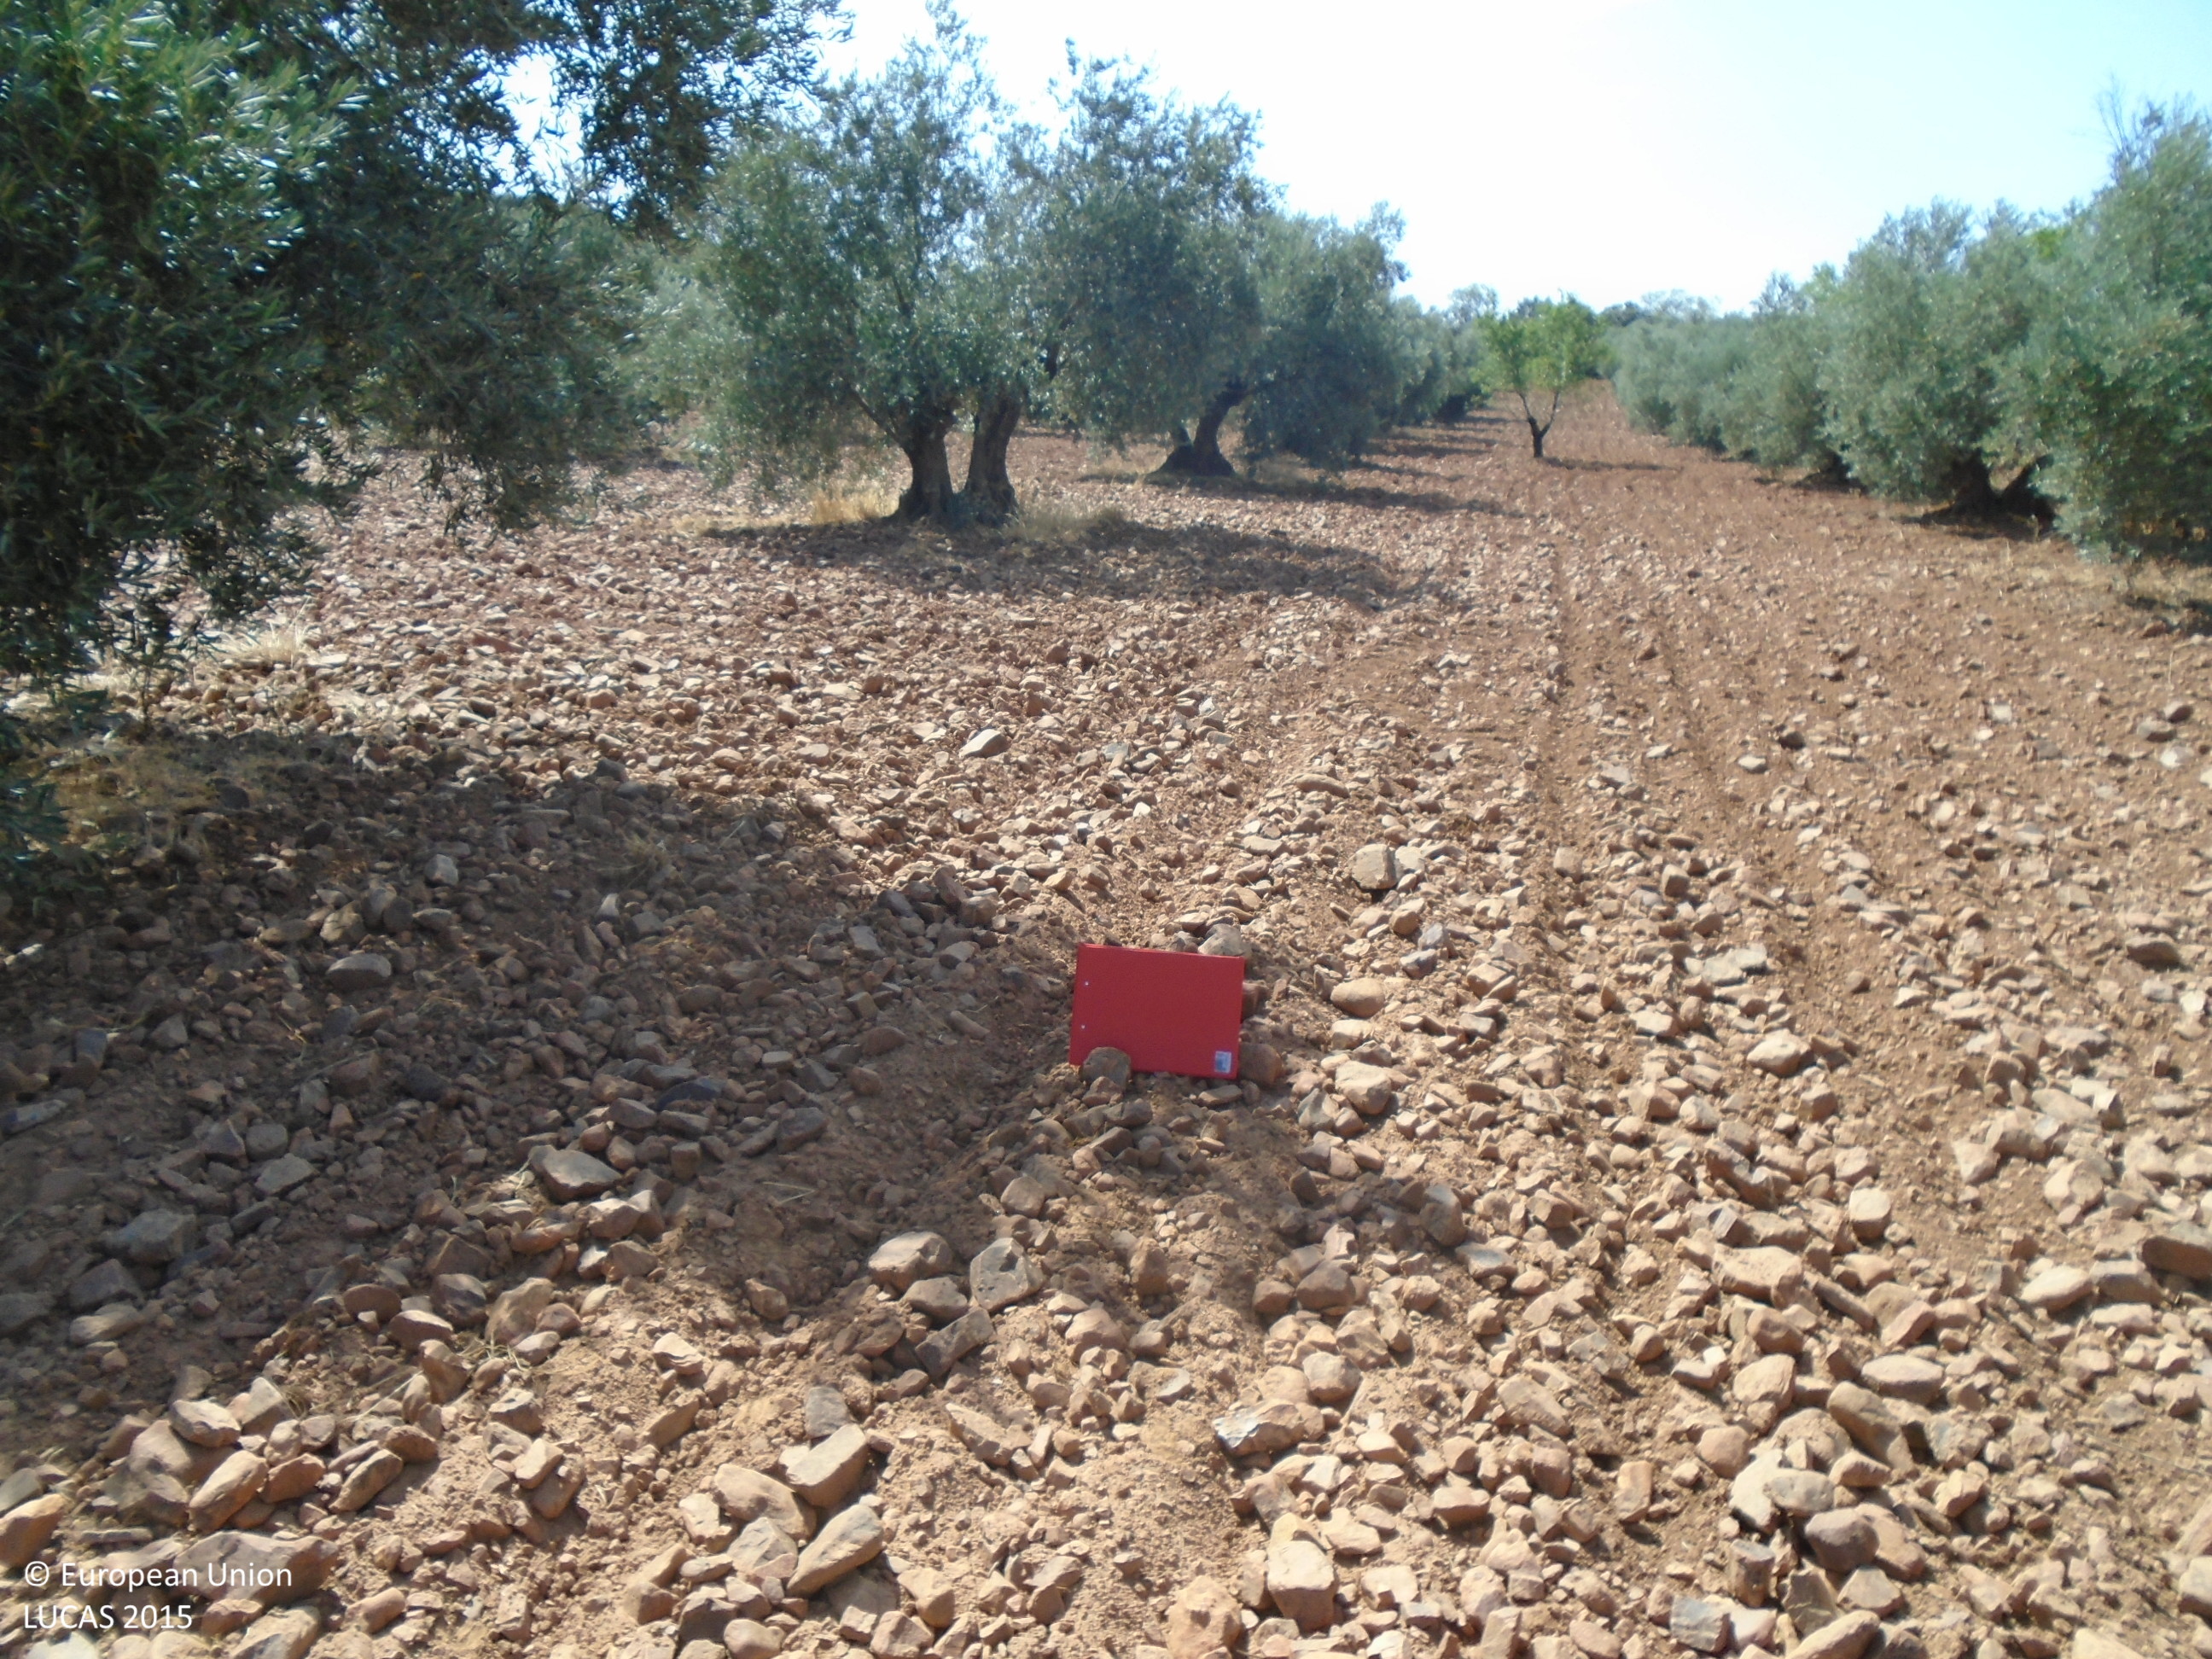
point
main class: Cropland
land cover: Olive groves
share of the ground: 10 - 25 %
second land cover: Other bare soil
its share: > 75 %
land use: Agriculture (excluding fallow land and kitchen gardens)
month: June
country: ES
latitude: 39.3101
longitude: -3.5080
